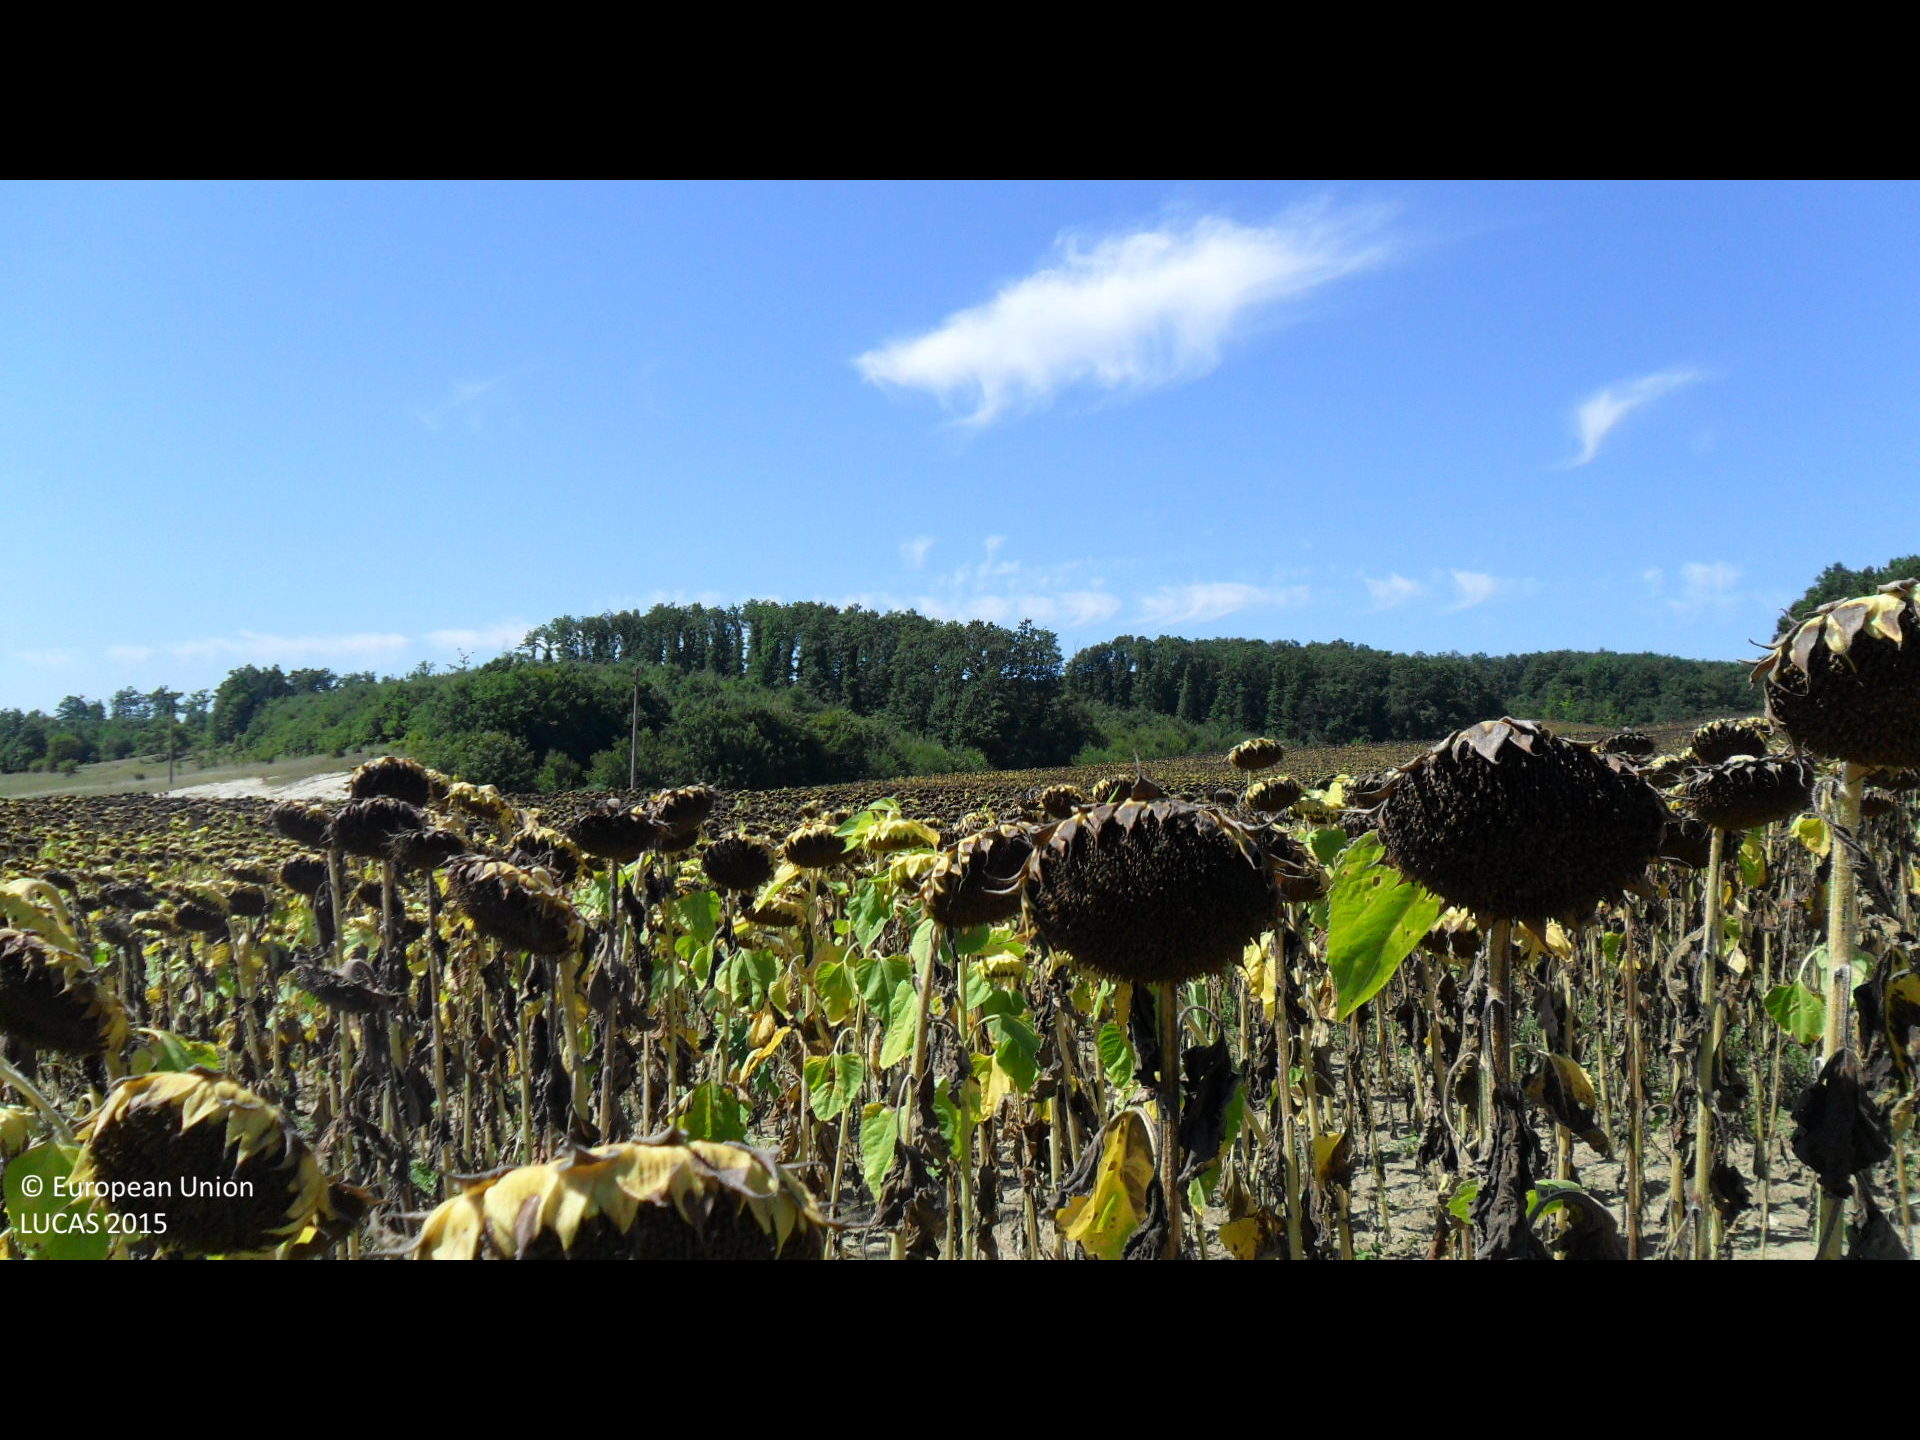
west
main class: Cropland
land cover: Sunflower
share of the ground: > 75 %
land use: Agriculture (excluding fallow land and kitchen gardens)
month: September
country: BG
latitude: 43.1820
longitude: 26.4000
